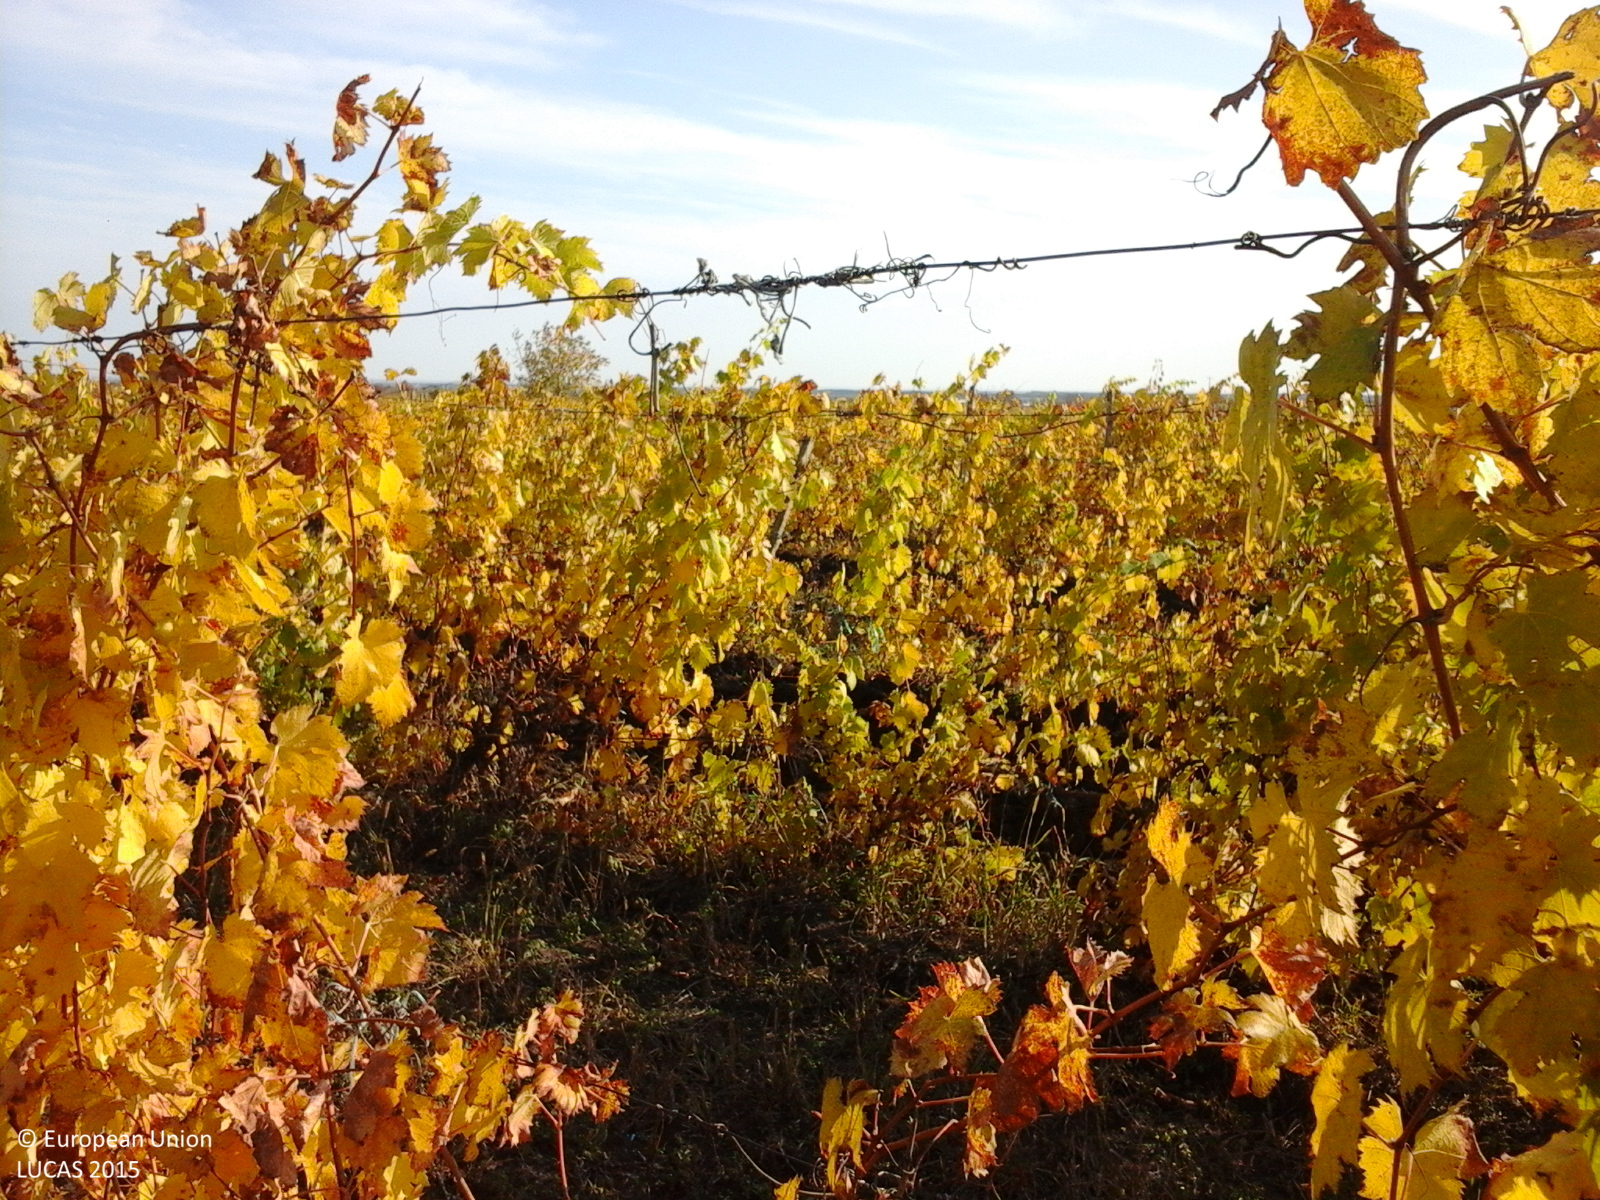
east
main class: Cropland
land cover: Vineyards
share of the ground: > 75 %
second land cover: Other bare soil
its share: > 75 %
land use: Agriculture (excluding fallow land and kitchen gardens)
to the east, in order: Vineyards; Other bare soil; Tracks; Grass margins; Vineyards; Grass margins; Tracks; Grass margins
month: October
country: RO
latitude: 45.5824
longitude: 27.1251
